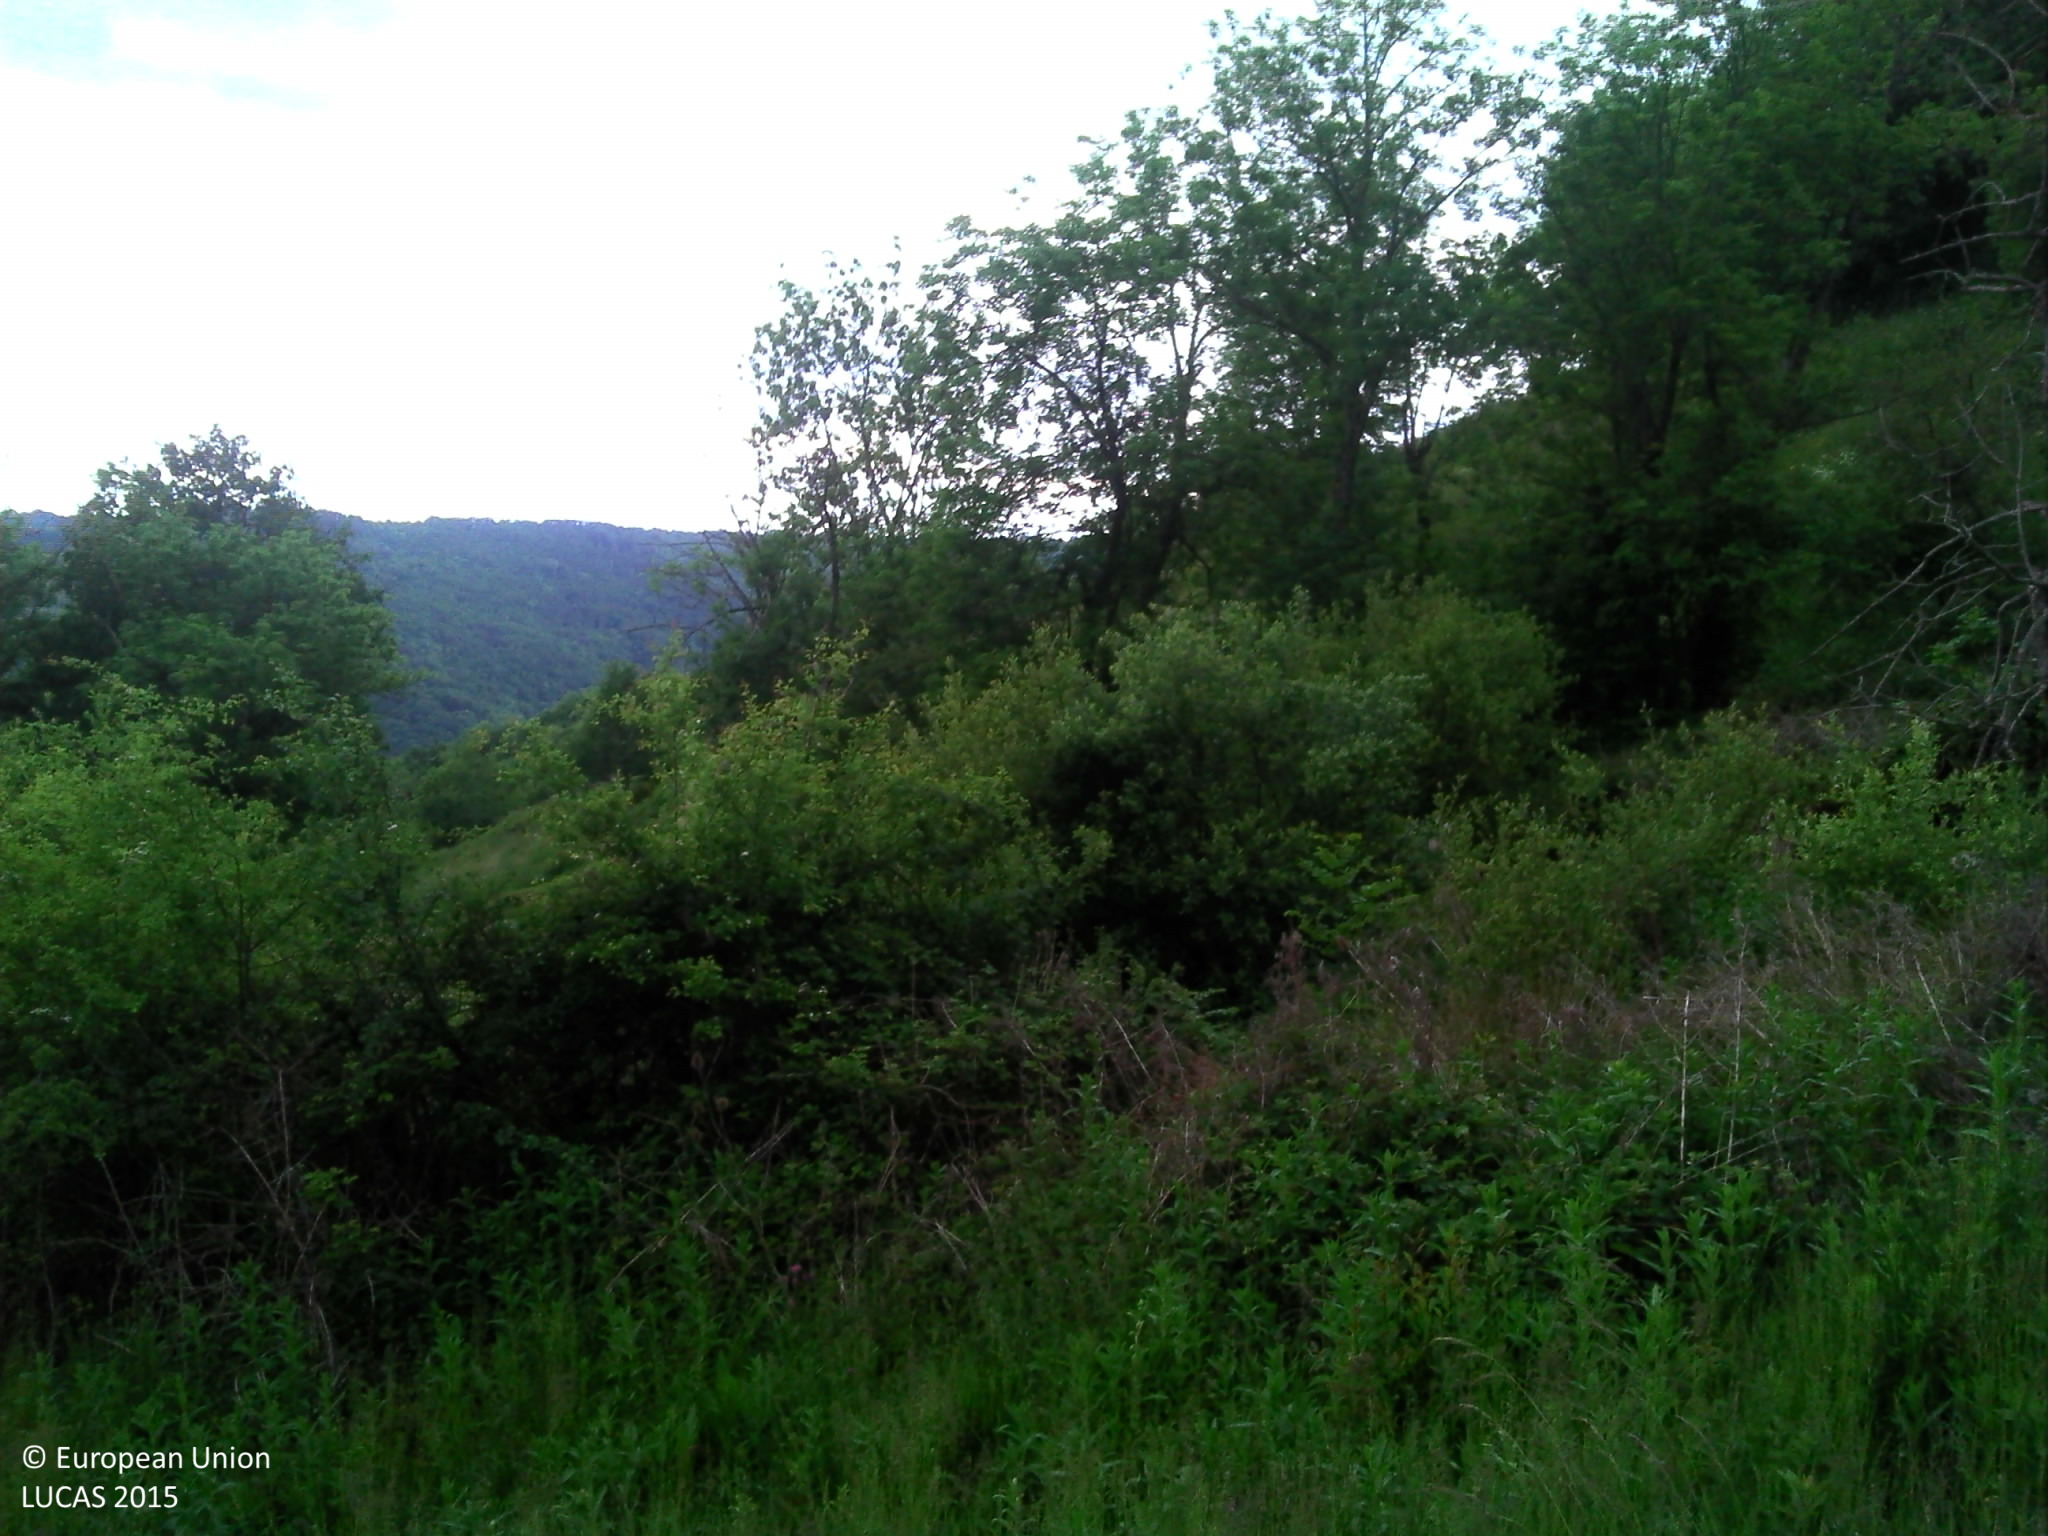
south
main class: Shrubland
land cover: Shrubland without tree cover
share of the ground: > 75 %
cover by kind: herbaceous plants 60 %, shrubs 40 %
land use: Agriculture (excluding fallow land and kitchen gardens)
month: May
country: FR
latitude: 45.2789
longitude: 3.1049
